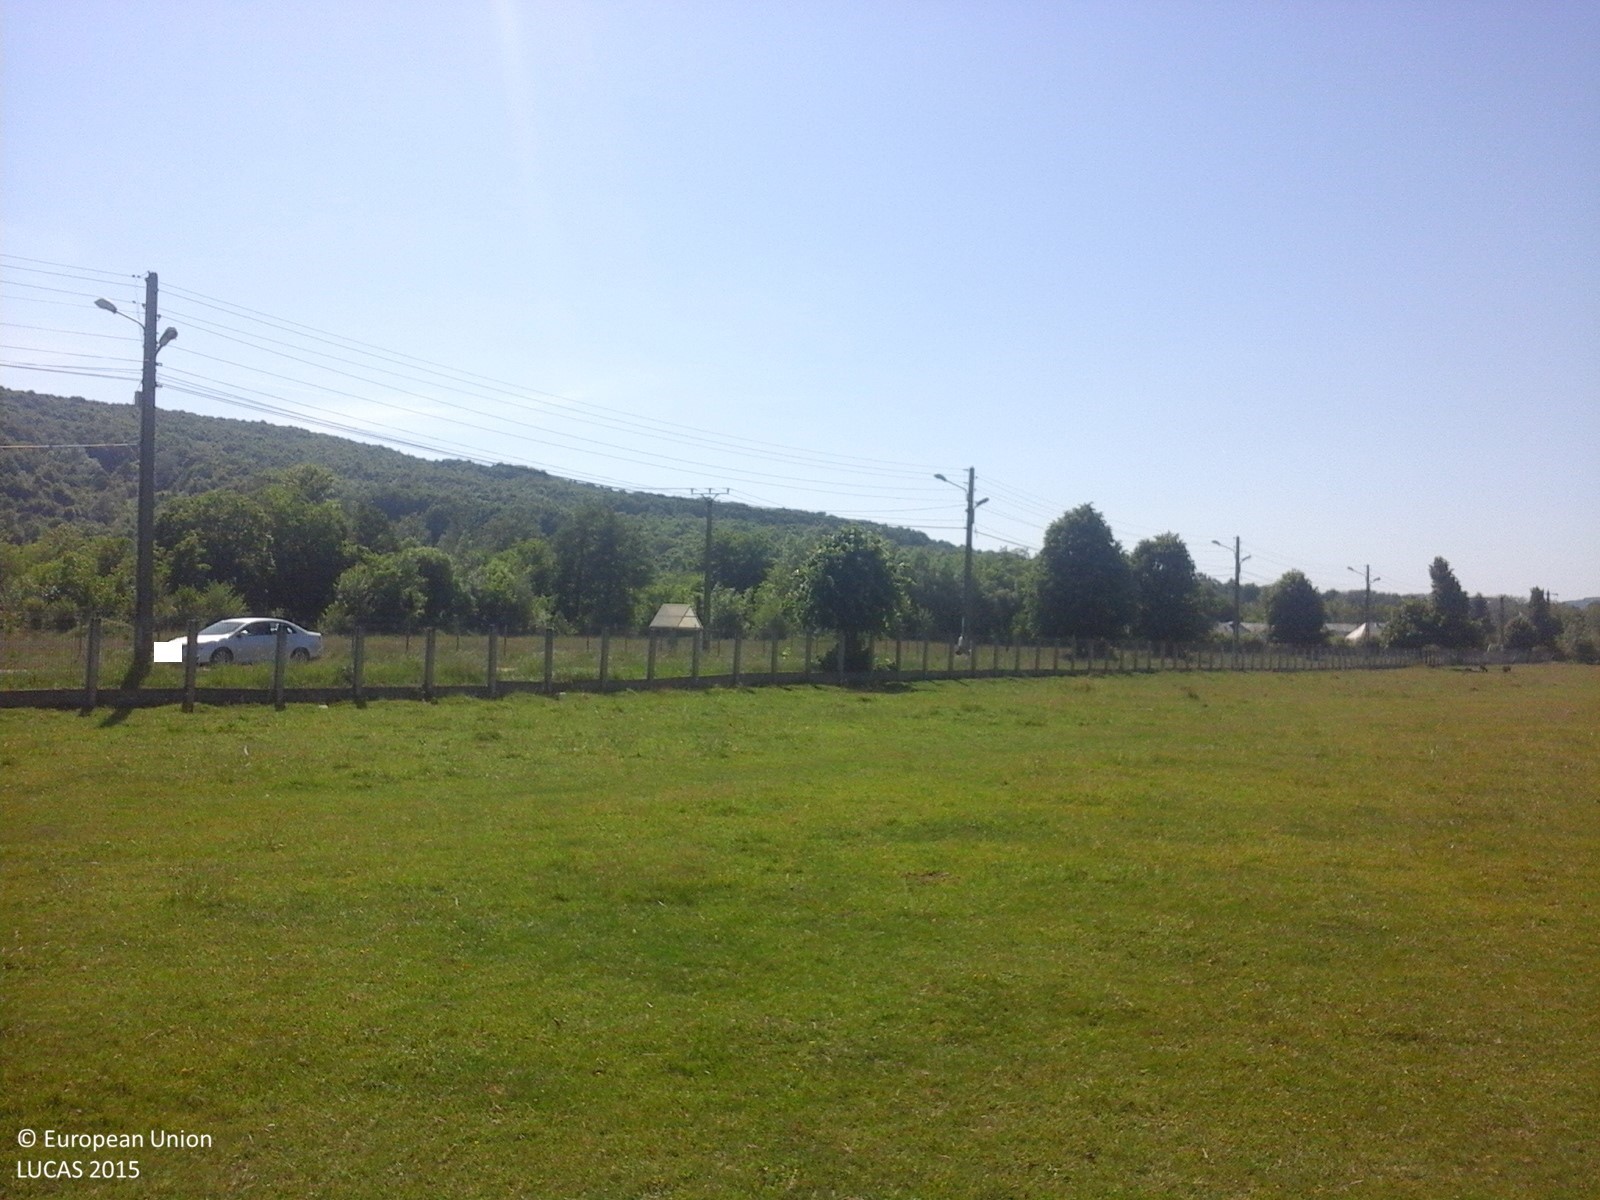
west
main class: Grassland
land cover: Grassland without tree/shrub cover
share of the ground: > 75 %
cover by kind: herbaceous plants 100 %
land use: Agriculture (excluding fallow land and kitchen gardens)
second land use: Amenities, museums, leisure
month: June
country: RO
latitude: 45.0469
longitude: 25.6273
